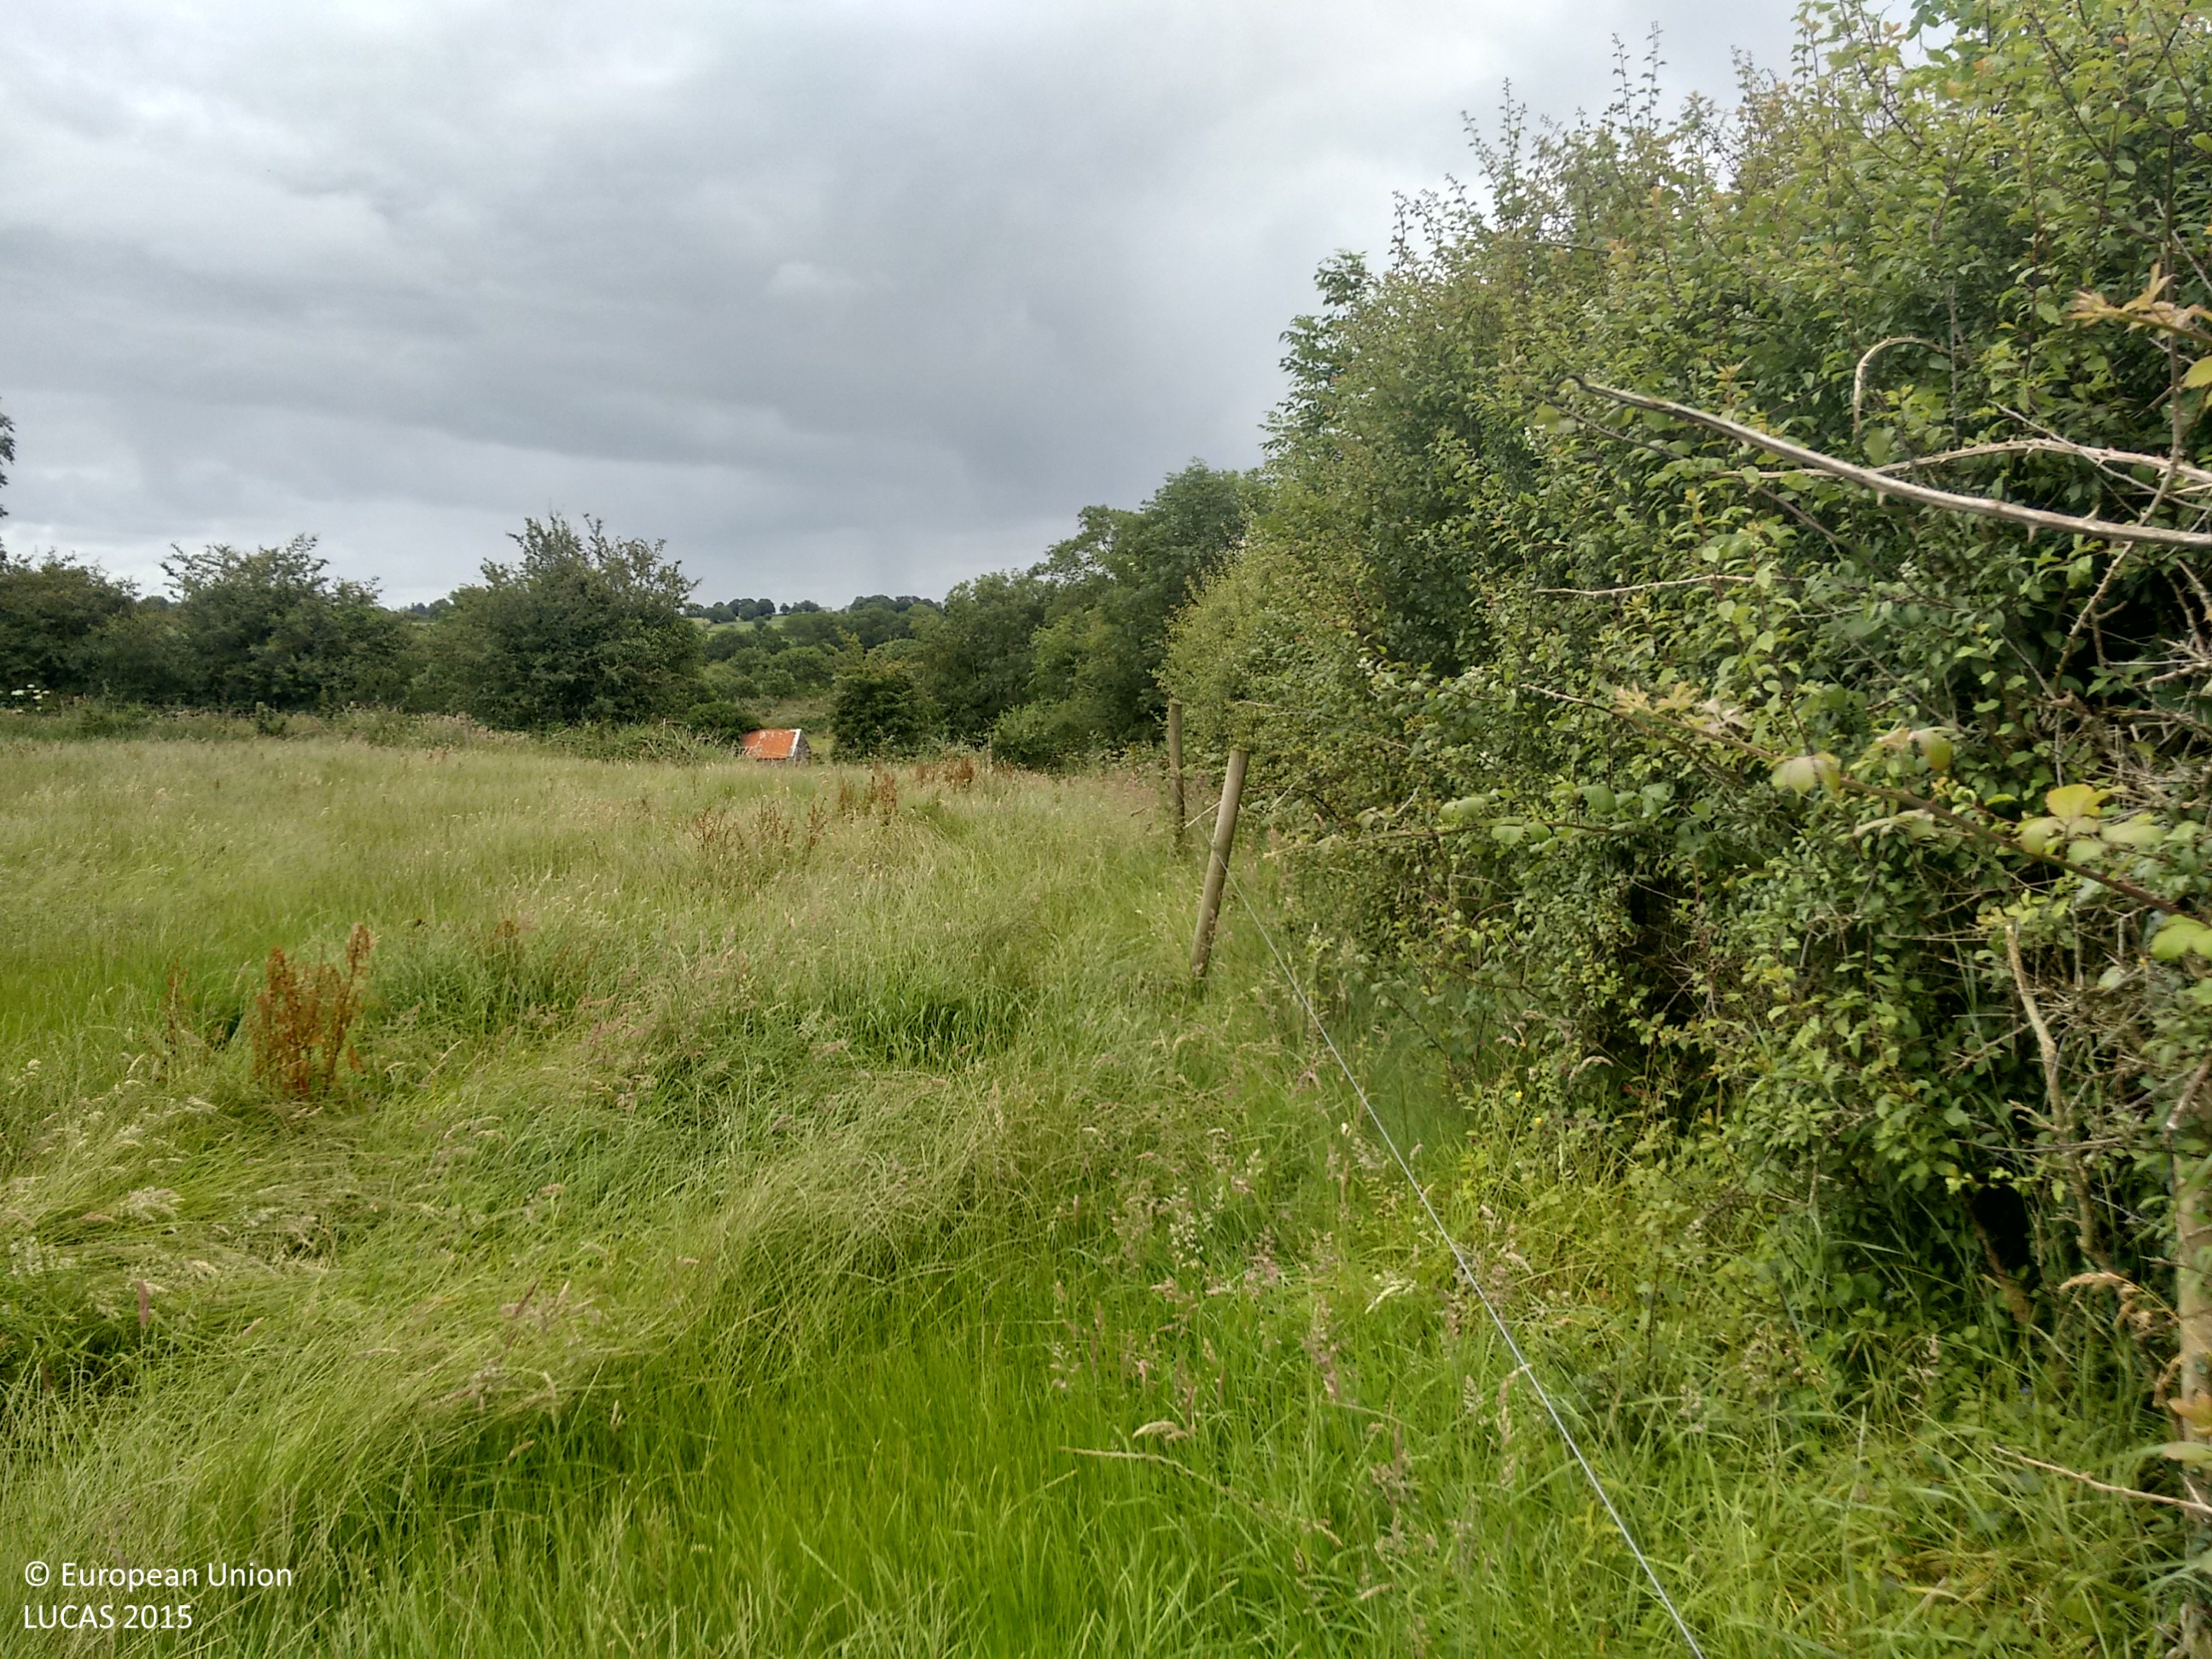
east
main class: Grassland
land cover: Grassland without tree/shrub cover
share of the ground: > 75 %
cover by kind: herbaceous plants 100 %
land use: Agriculture (excluding fallow land and kitchen gardens)
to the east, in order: Grassland without tree/shrub cover; Broadleaved woodland; Tracks; Broadleaved woodland; Fences; Grassland without tree/shrub cover; Broadleaved woodland; Fences; Dry stone walls; Tracks; Fences; Grassland without tree/shrub cover; Fences; Grassland without tree/shrub cover
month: July
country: IE
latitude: 53.7181
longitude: -9.1759
